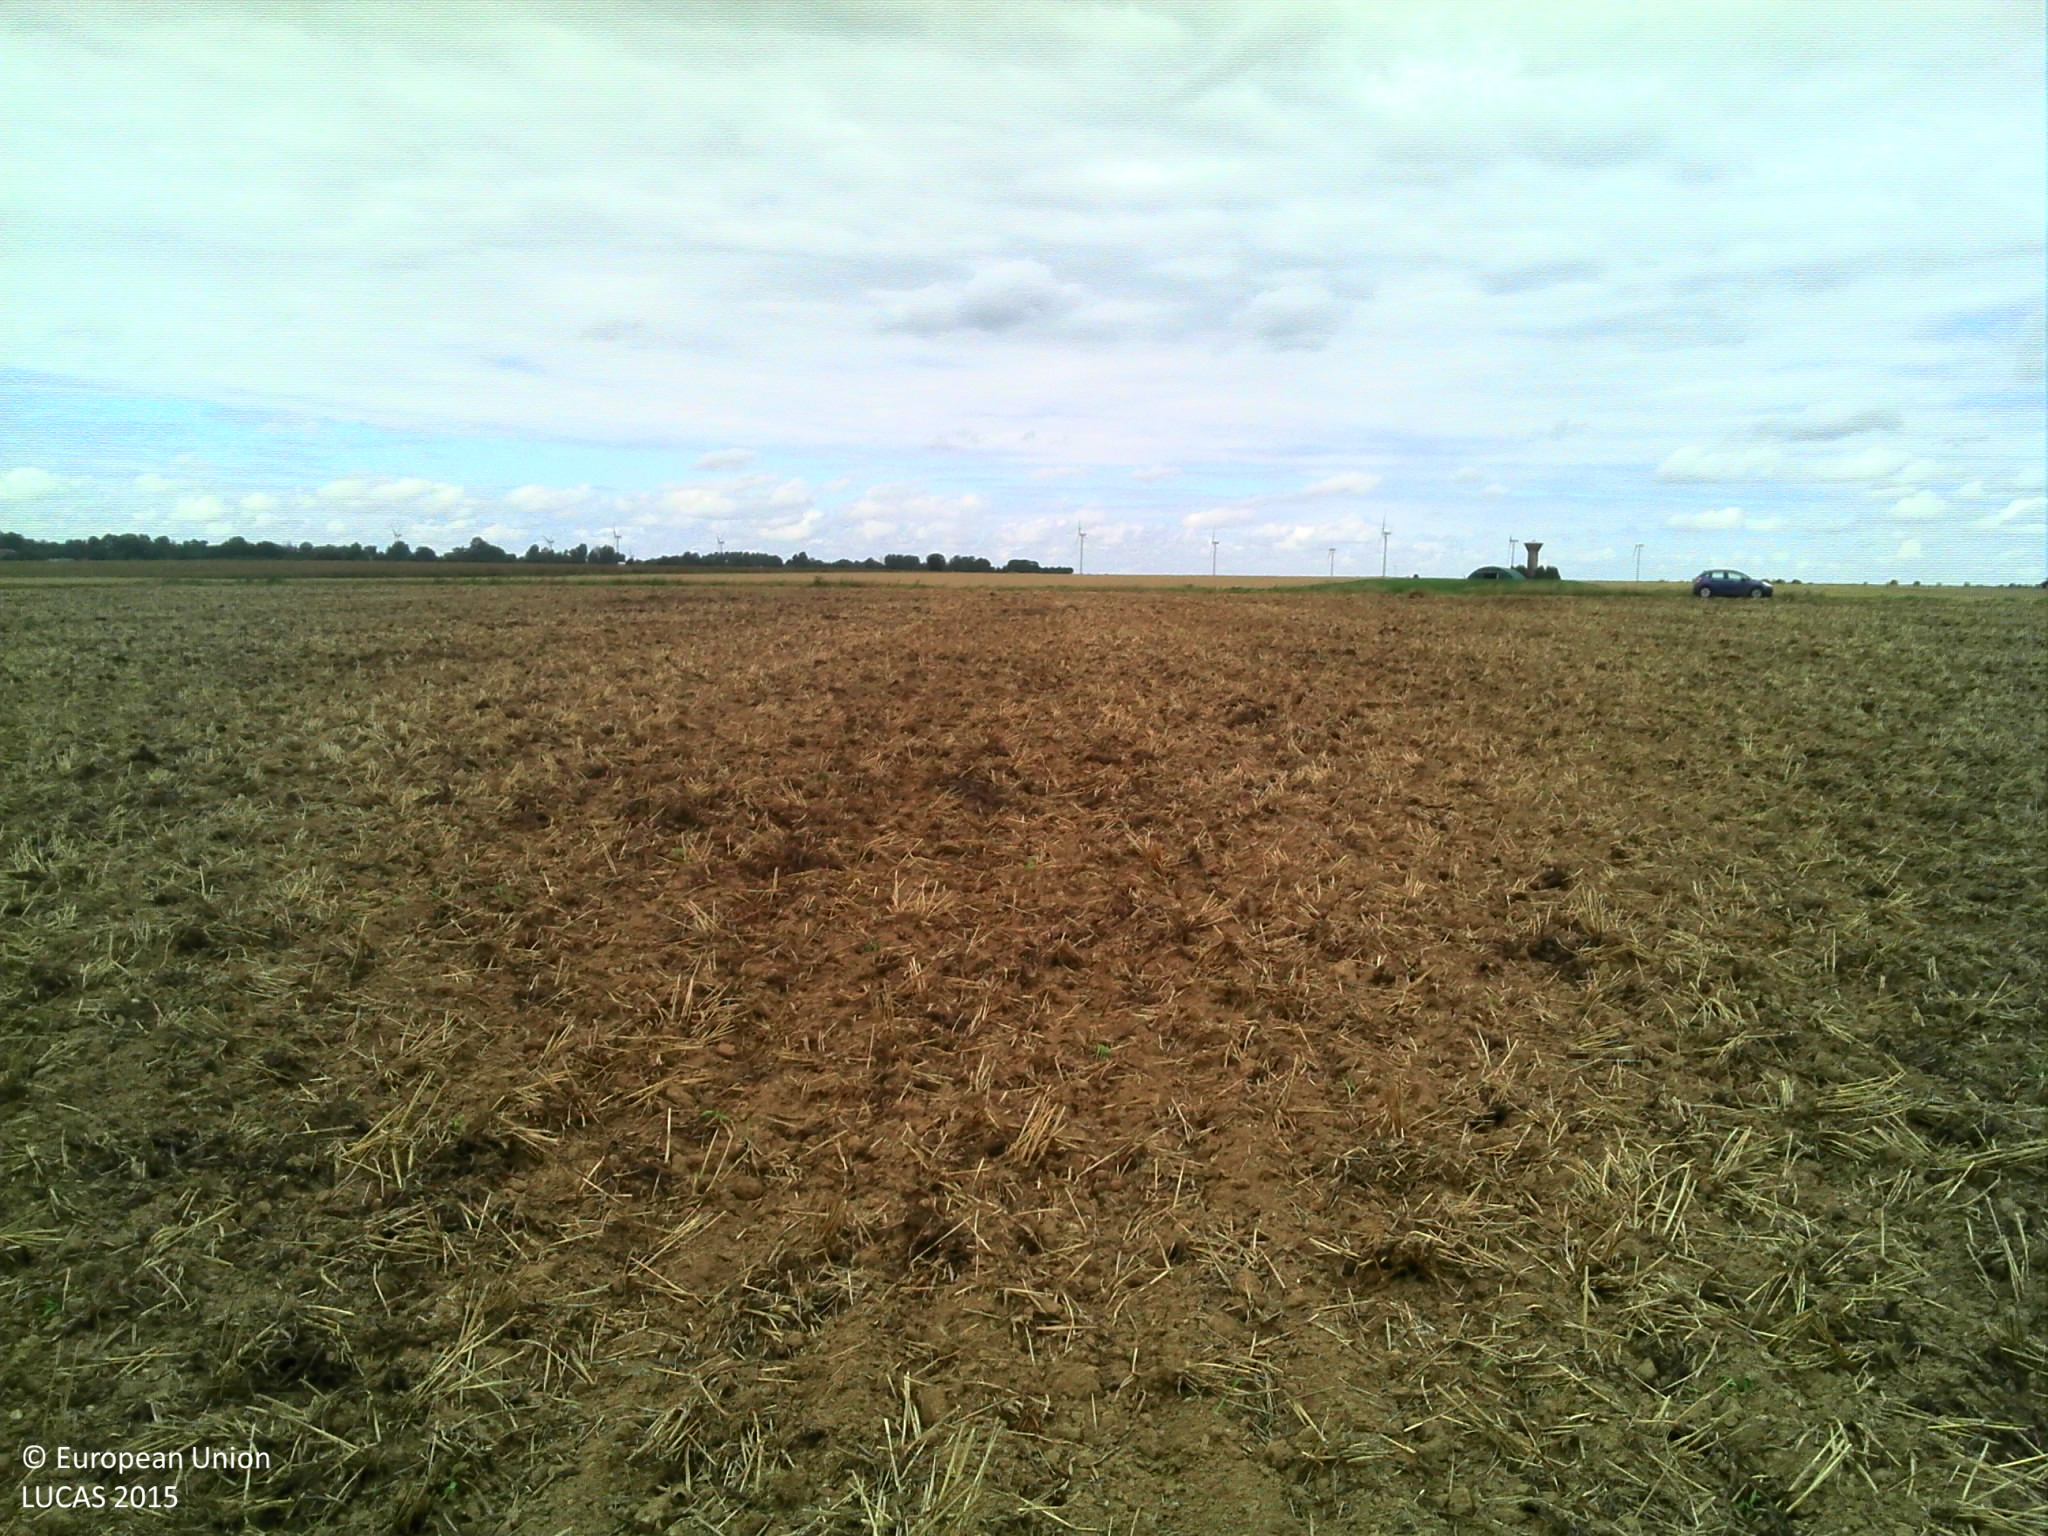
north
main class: Cropland
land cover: Barley
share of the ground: 10 - 25 %
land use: Agriculture (excluding fallow land and kitchen gardens)
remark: Harvested field
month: July
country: FR
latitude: 50.1293
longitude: 2.1376
